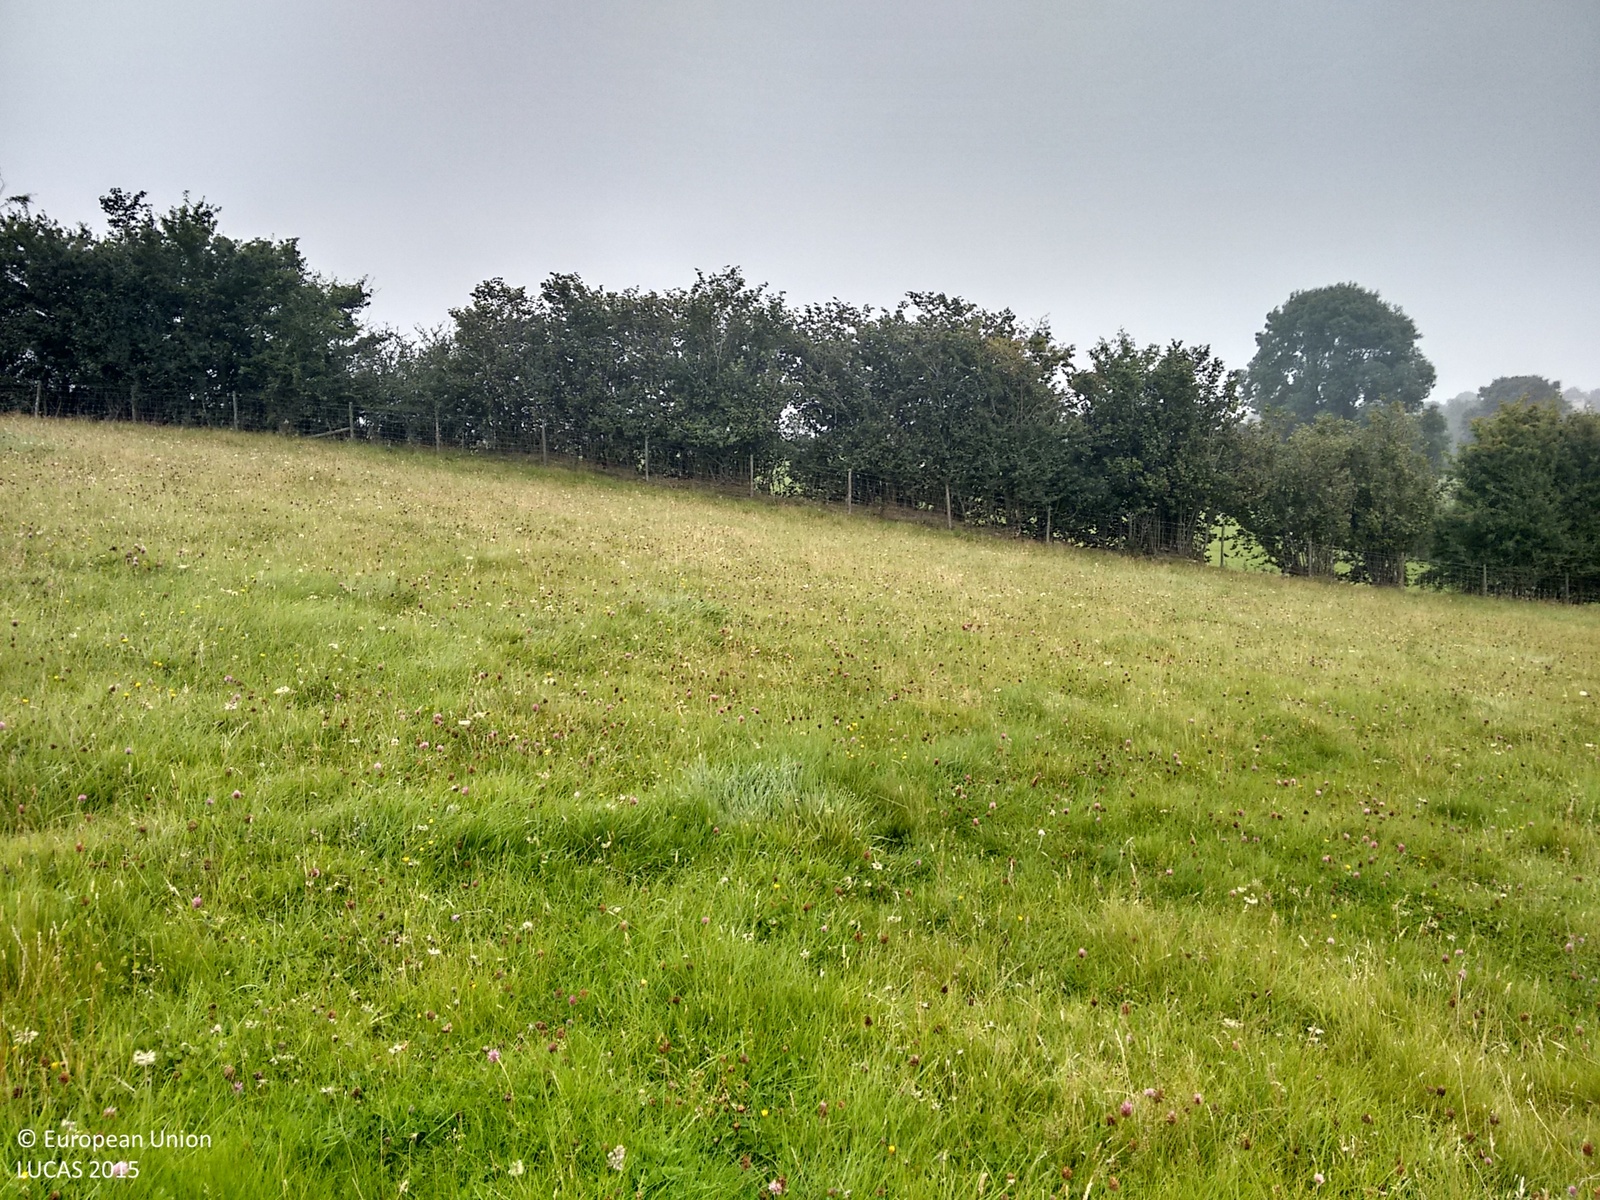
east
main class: Grassland
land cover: Grassland without tree/shrub cover
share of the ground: > 75 %
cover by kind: herbaceous plants 100 %
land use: Agriculture (excluding fallow land and kitchen gardens)
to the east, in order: Grassland without tree/shrub cover; Fences; Managed hedges; Rivers and streams; Fences; Grassland without tree/shrub cover
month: September
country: GB
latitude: 52.1335
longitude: -3.1533
